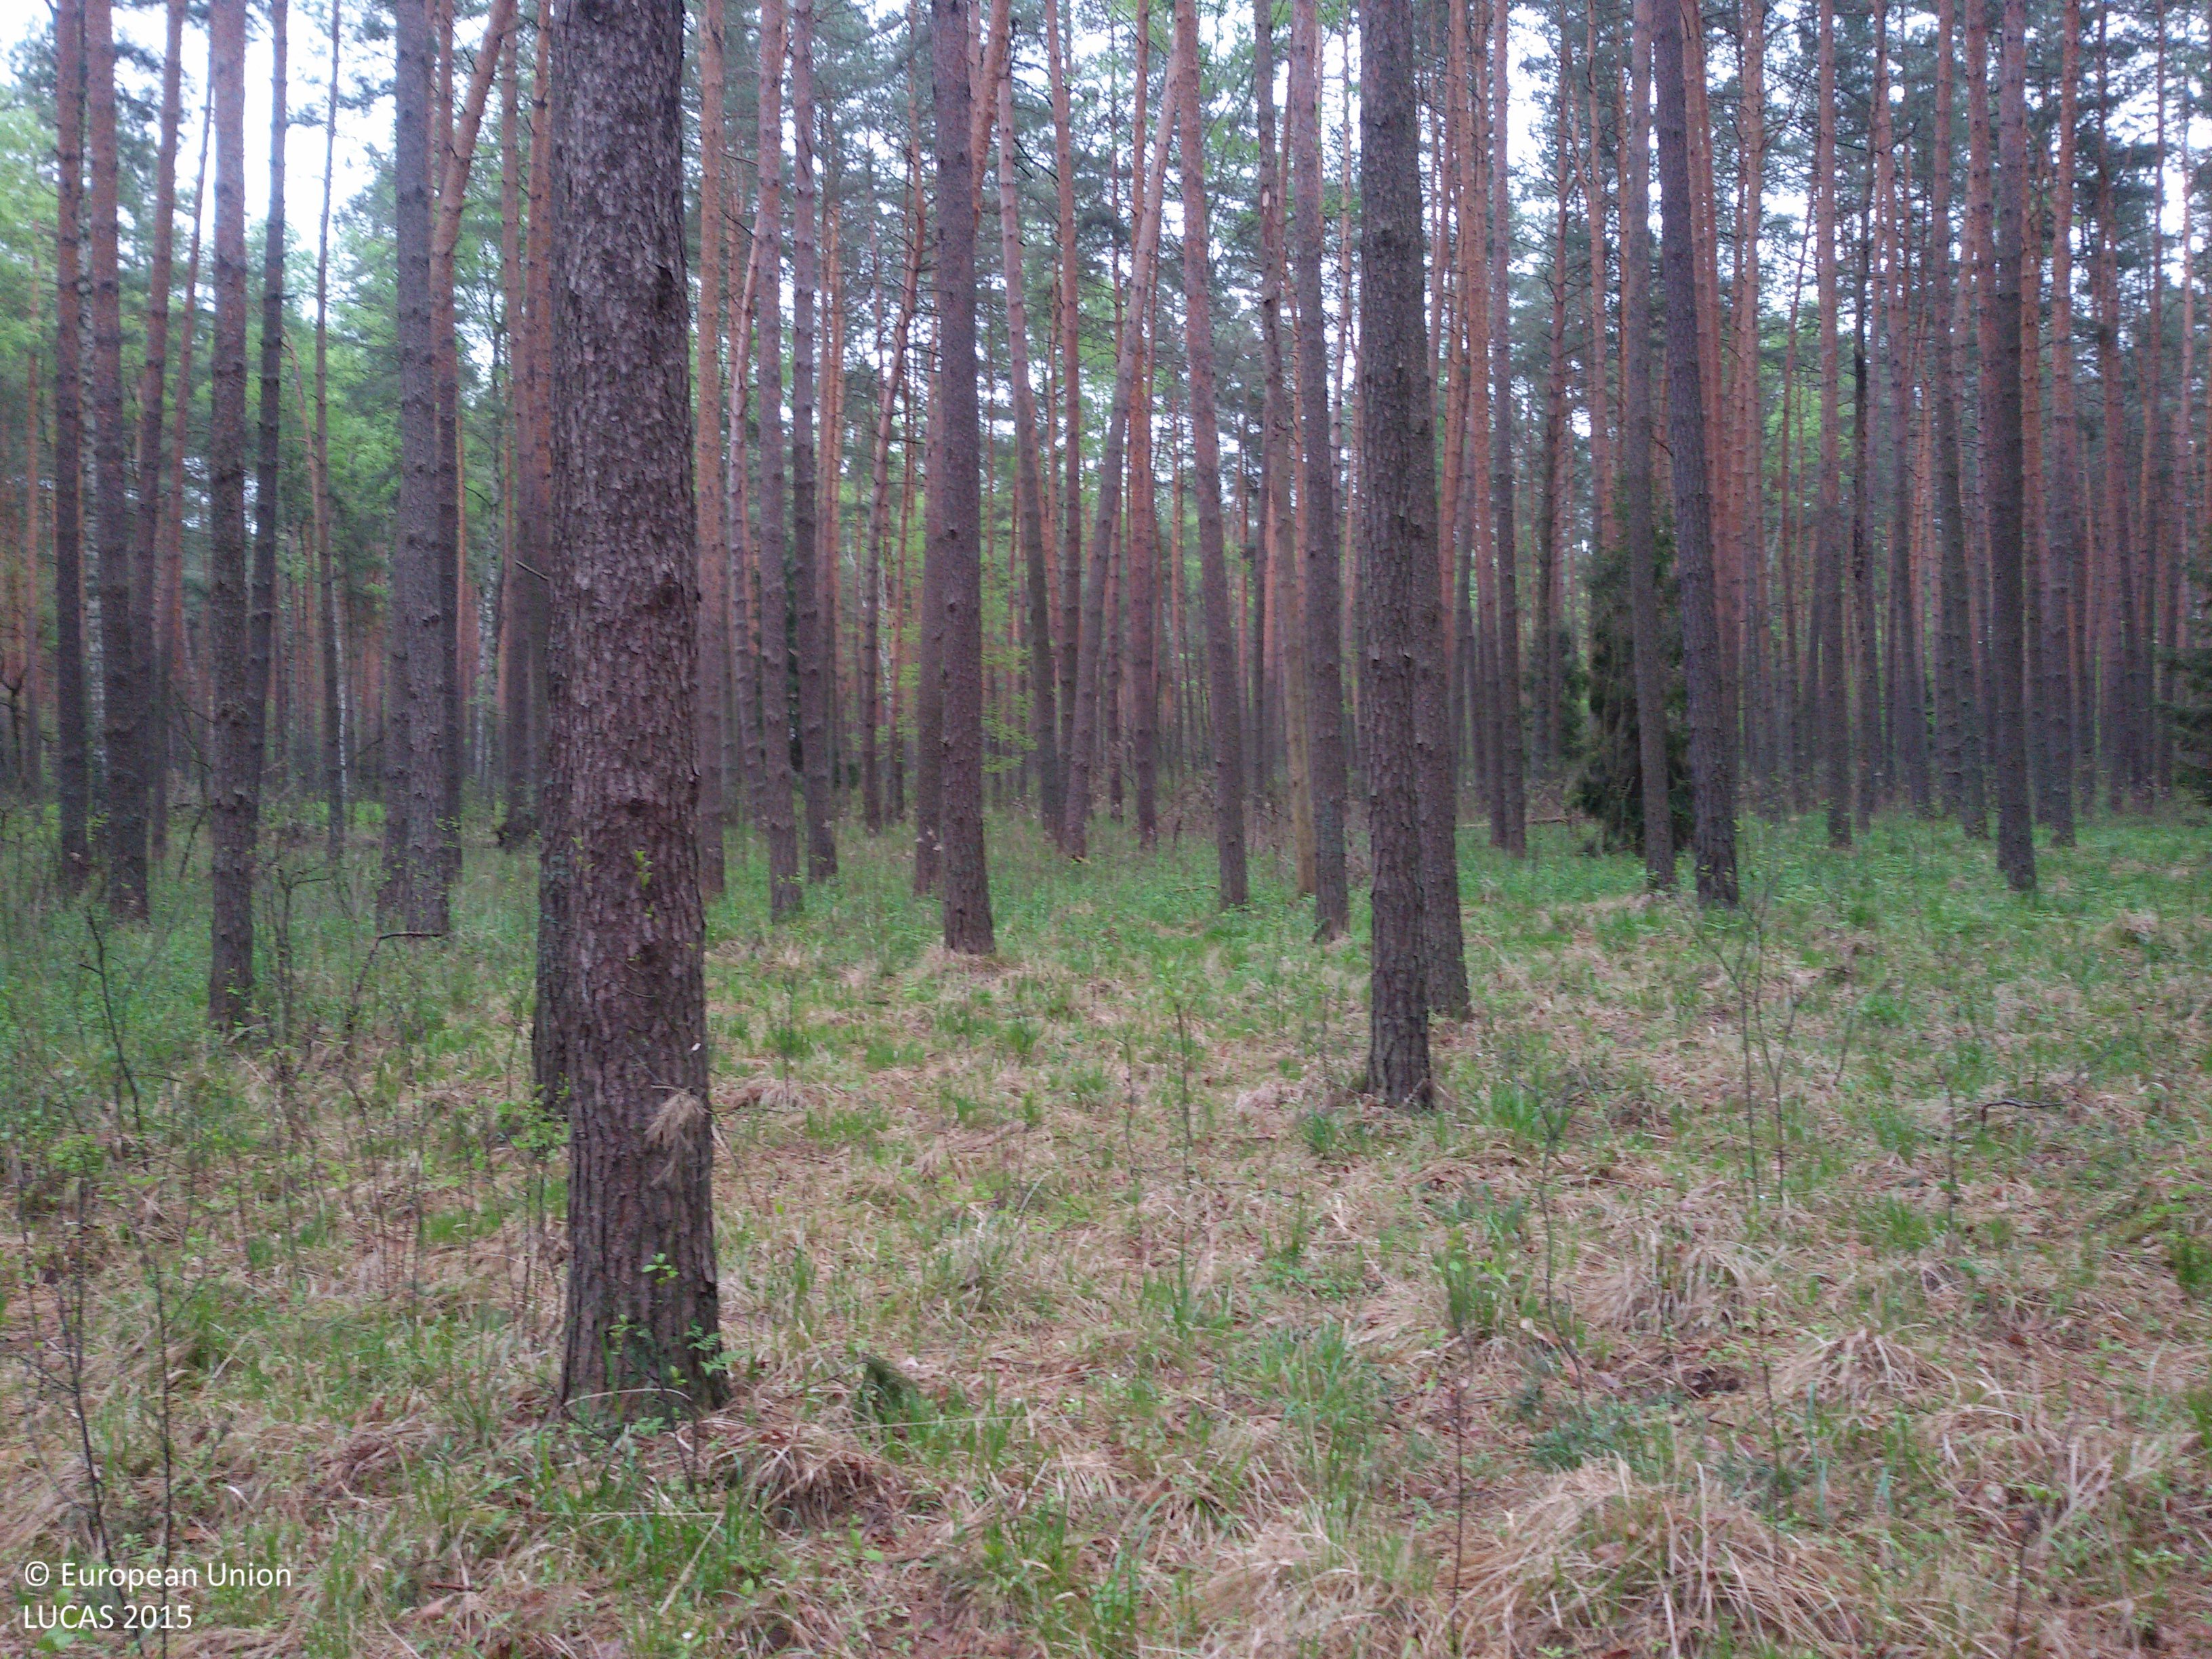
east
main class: Woodland
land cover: Pine dominated coniferous woodland
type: hemiboreal forest and nemoral coniferous forest and mixed broadleaved-coniferous forest
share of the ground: > 75 %
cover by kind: coniferous forest trees 85 %, herbaceous plants 15 %
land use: Forestry
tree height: > 5 m
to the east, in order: Pine dominated coniferous woodland
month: May
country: PL
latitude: 50.3894
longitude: 21.5997
